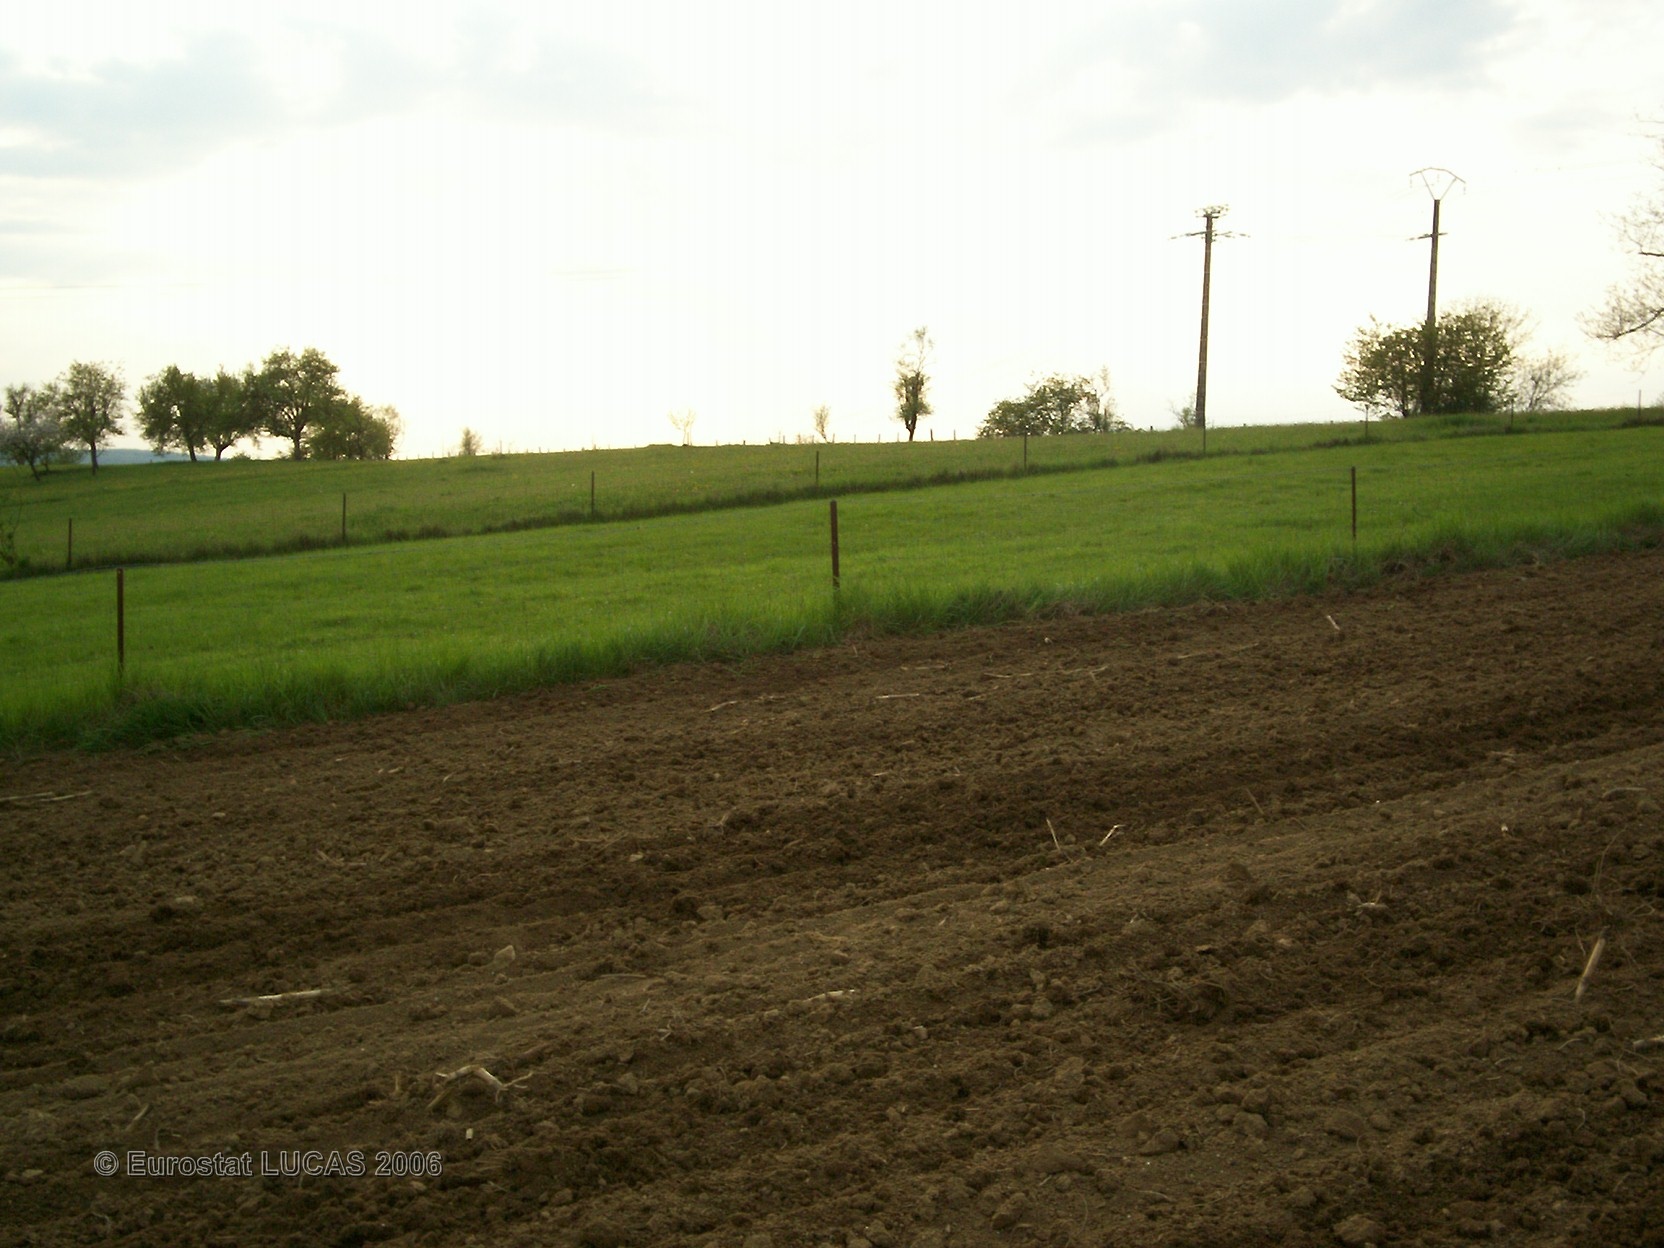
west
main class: Cropland
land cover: Maize
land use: Agriculture (excluding fallow land and kitchen gardens)
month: May
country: FR
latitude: 47.6289
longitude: 7.1670
